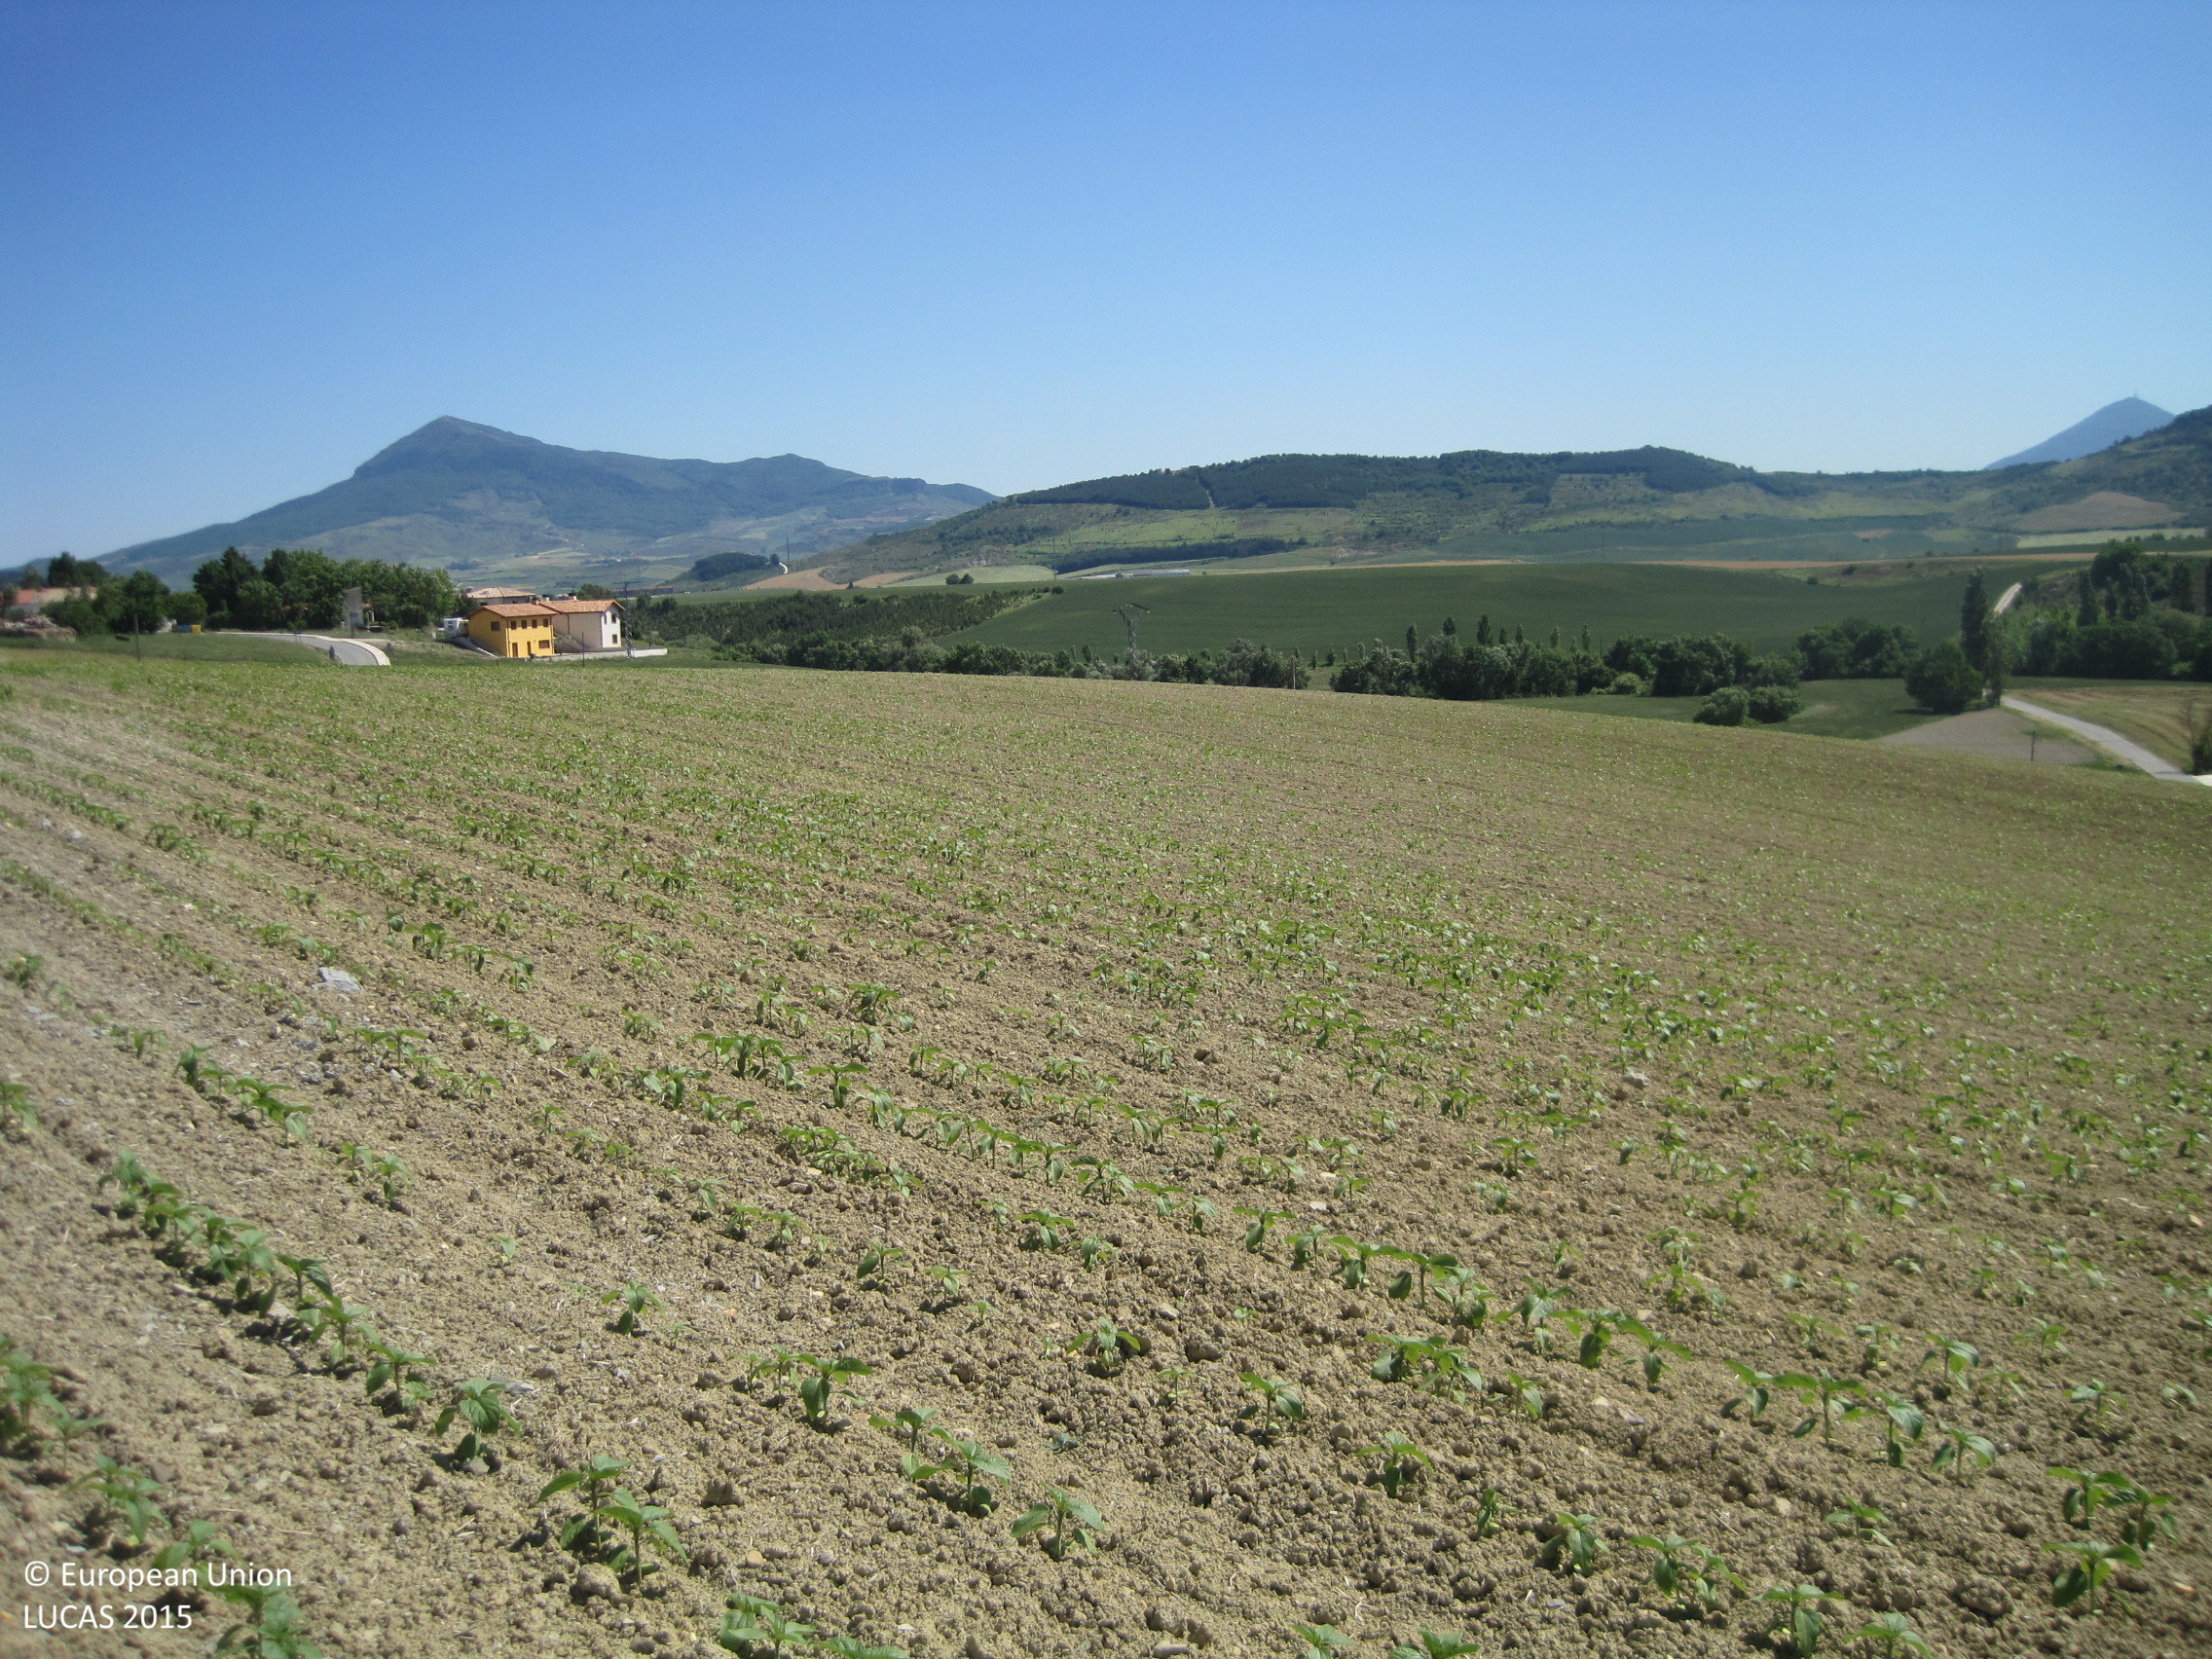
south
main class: Cropland
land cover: Sunflower
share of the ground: < 10 %
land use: Agriculture (excluding fallow land and kitchen gardens)
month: May
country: ES
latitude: 42.8019
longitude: -1.4699
